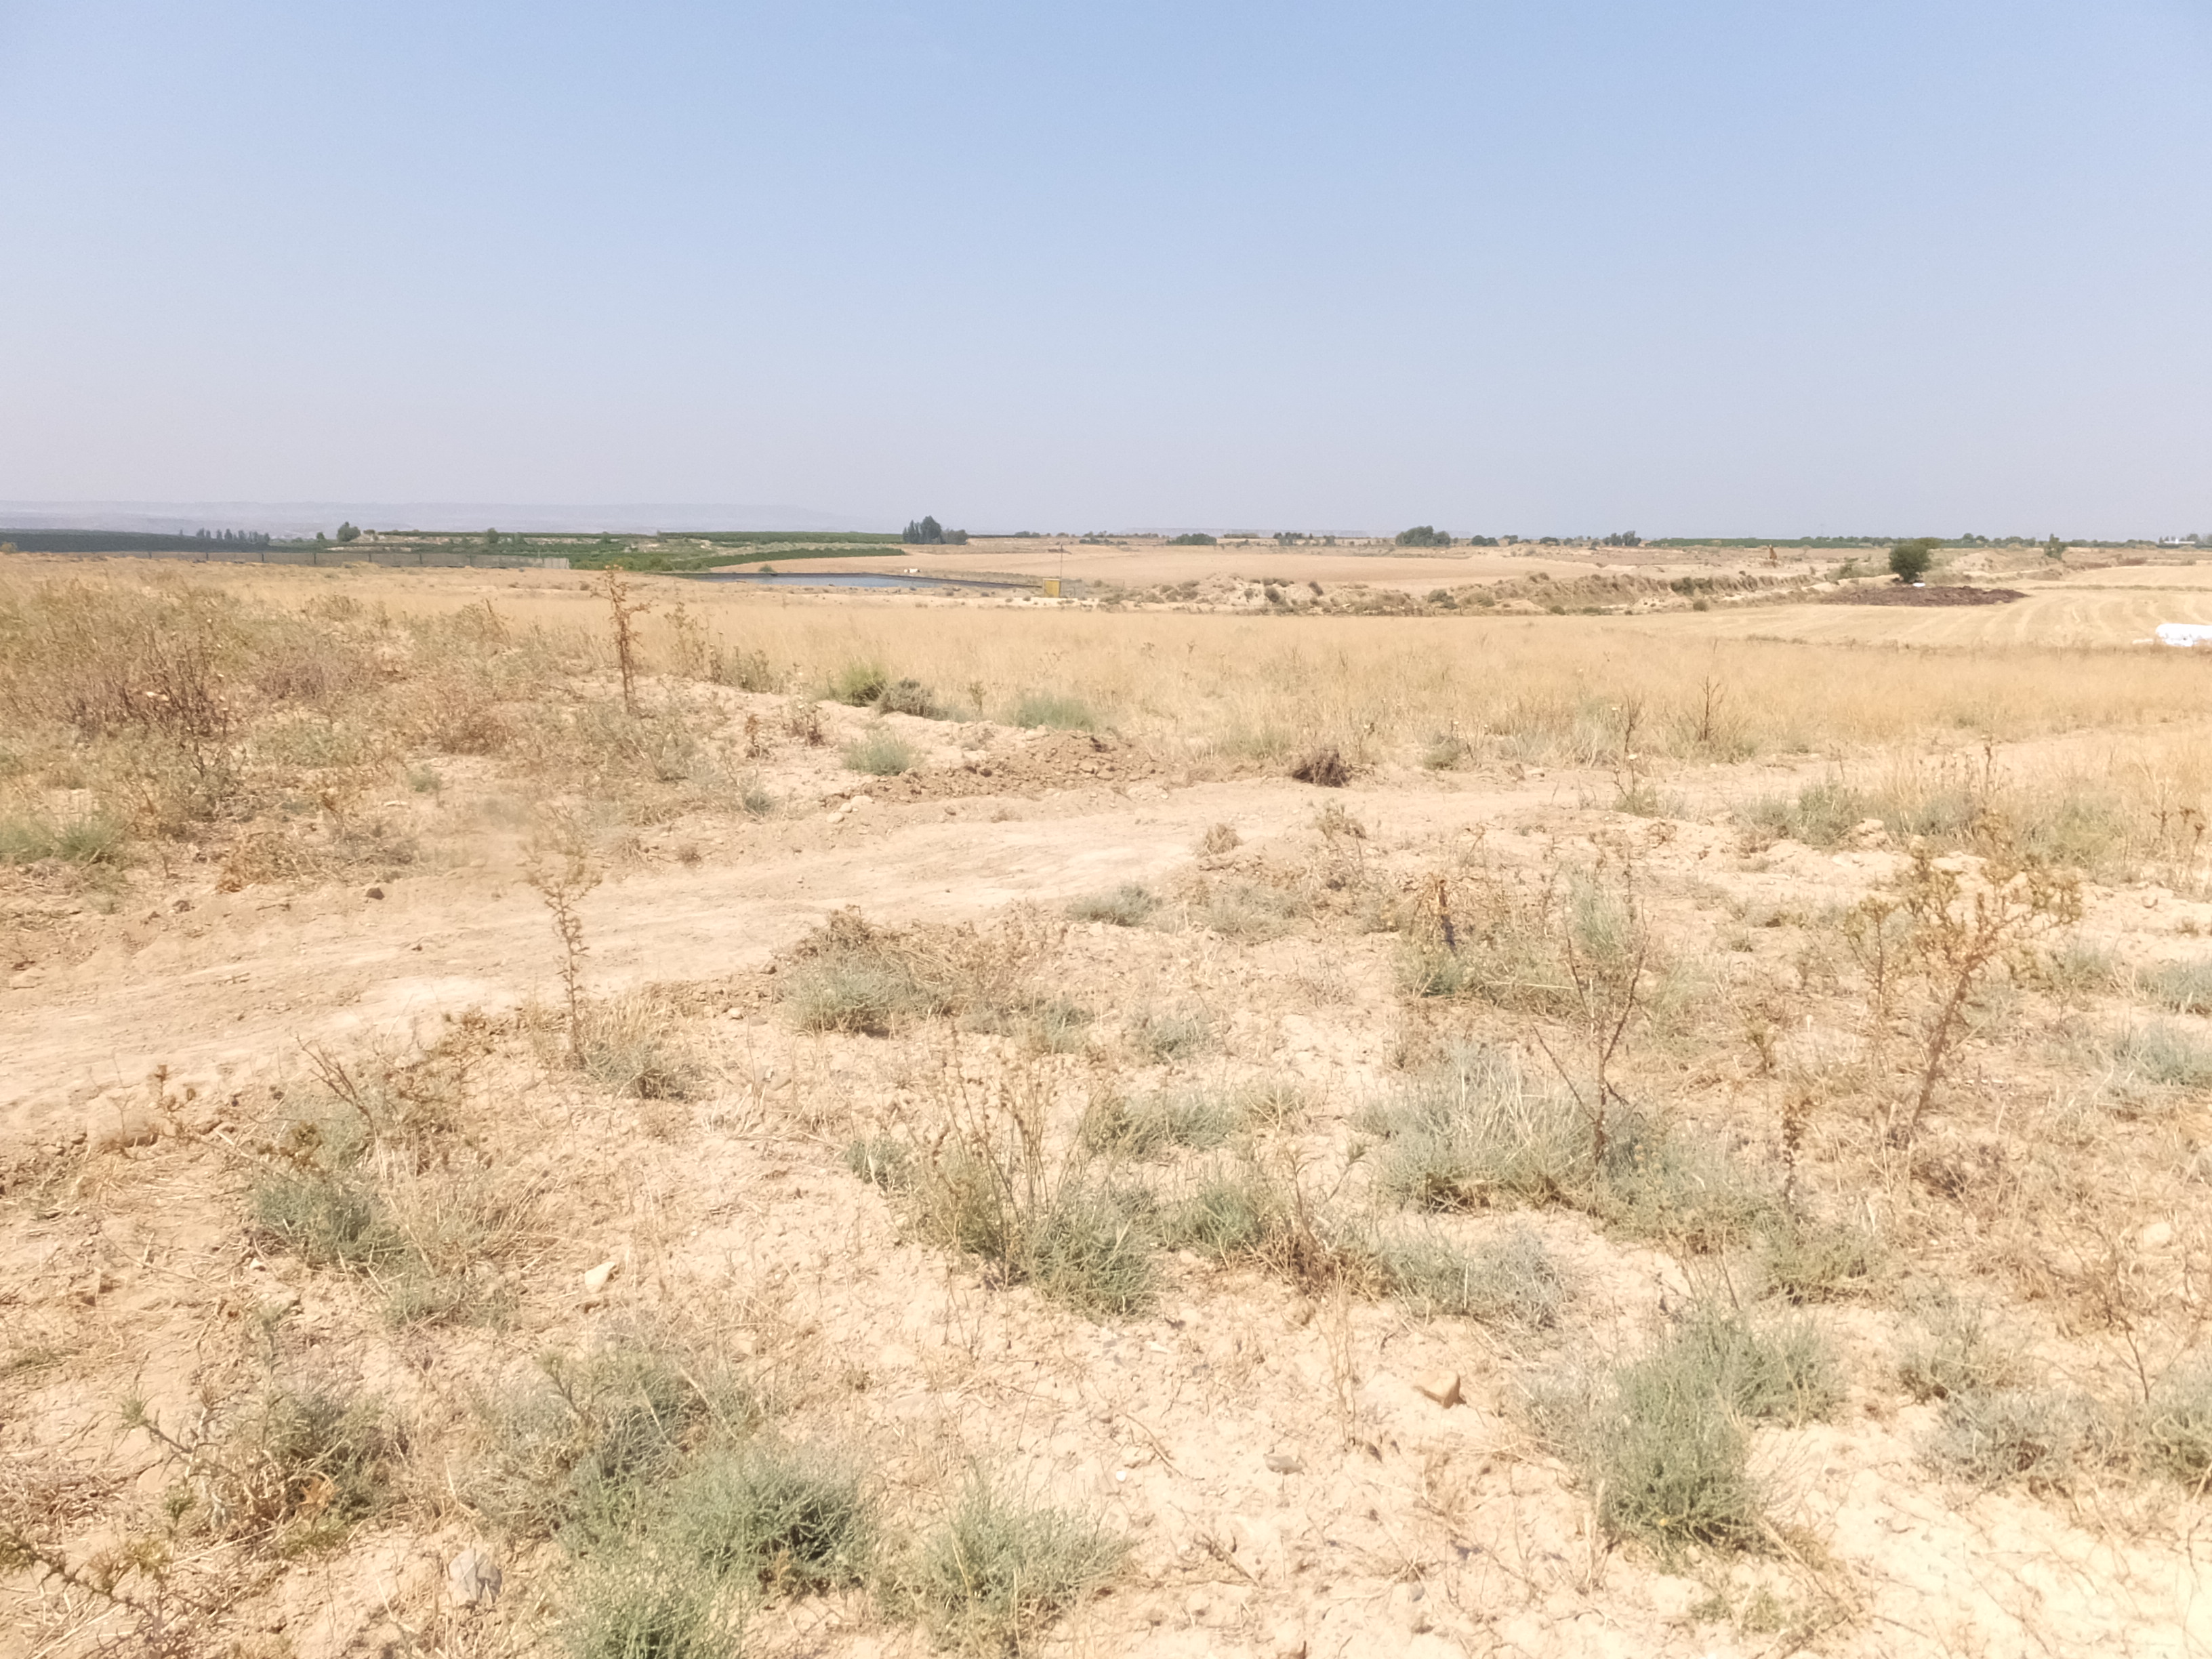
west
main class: Grassland
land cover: Spontaneously vegetated surfaces
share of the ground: > 75 %
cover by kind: herbaceous plants 75 %, unconsolidated bare surface 20 %, shrubs 5 %
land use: Fallow land
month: July
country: ES
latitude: 41.6908
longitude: 0.2412
